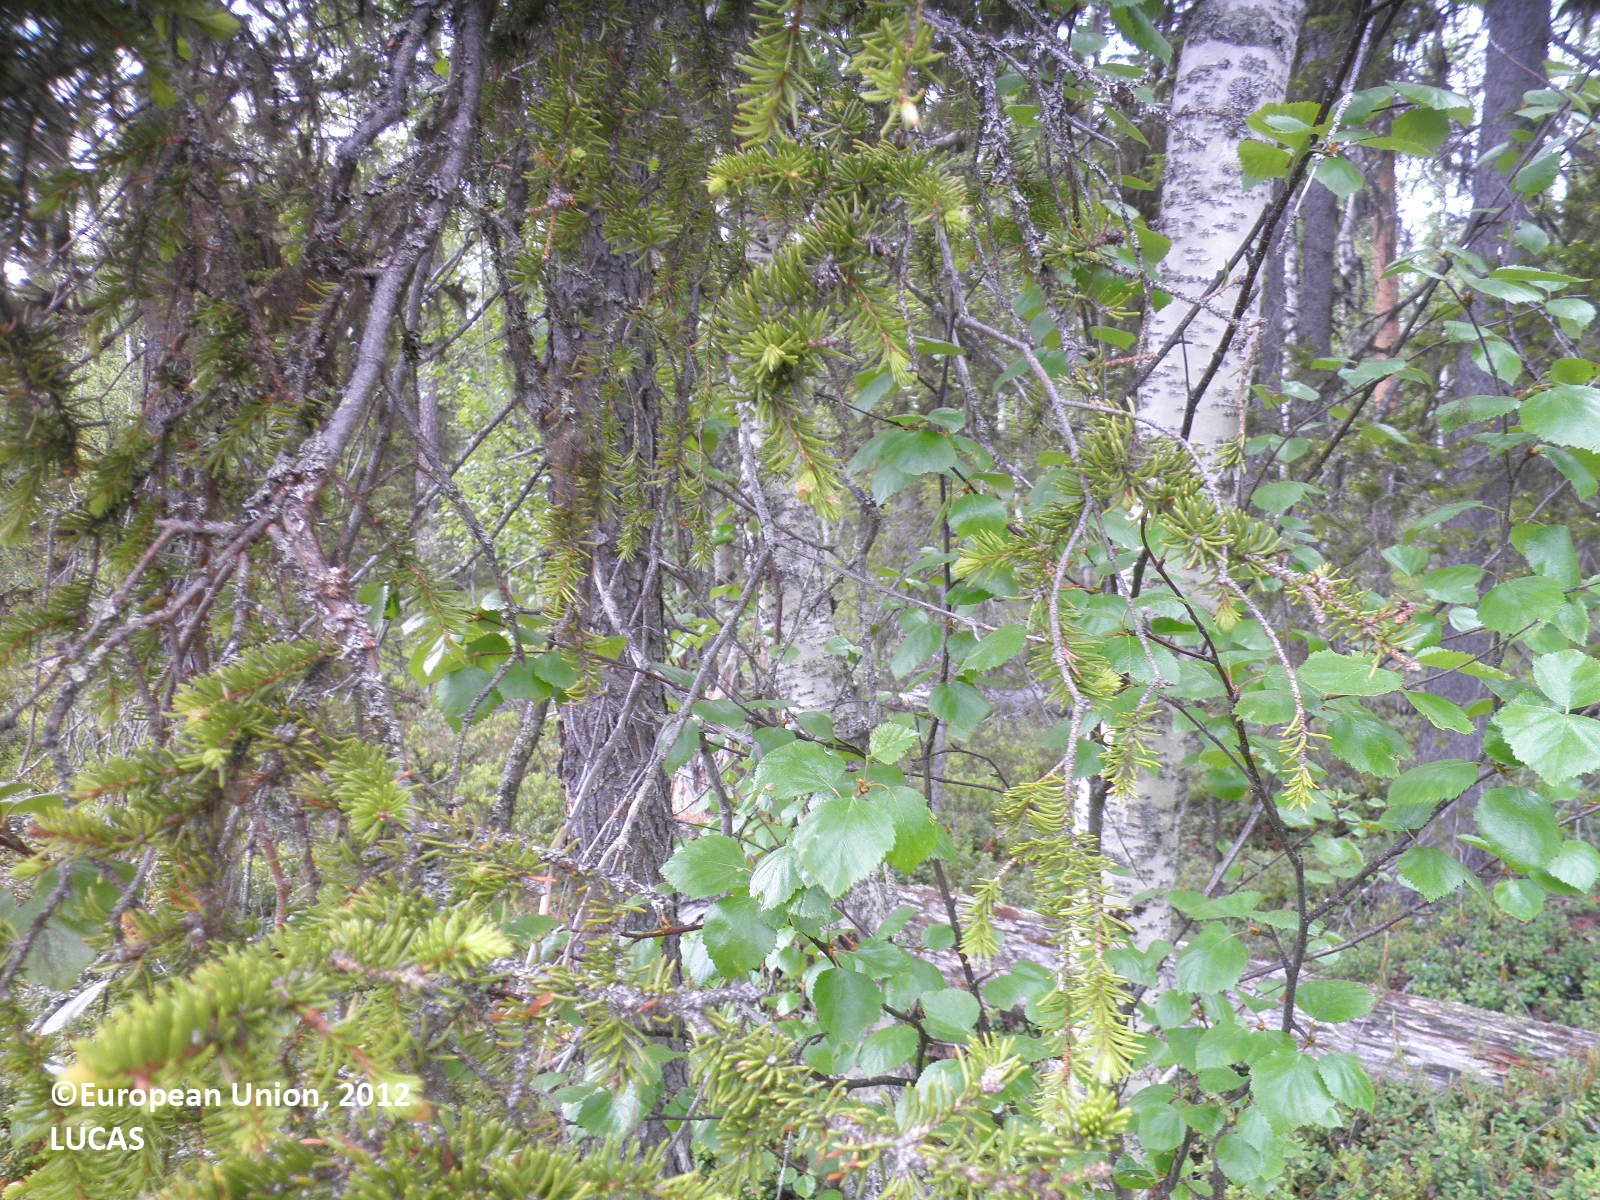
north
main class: Woodland
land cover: Spruce dominated mixed woodland
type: boreal forest
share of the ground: 25 - 50 %
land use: Forestry
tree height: > 5 m
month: June
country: FI
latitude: 67.8191
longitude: 25.6897
